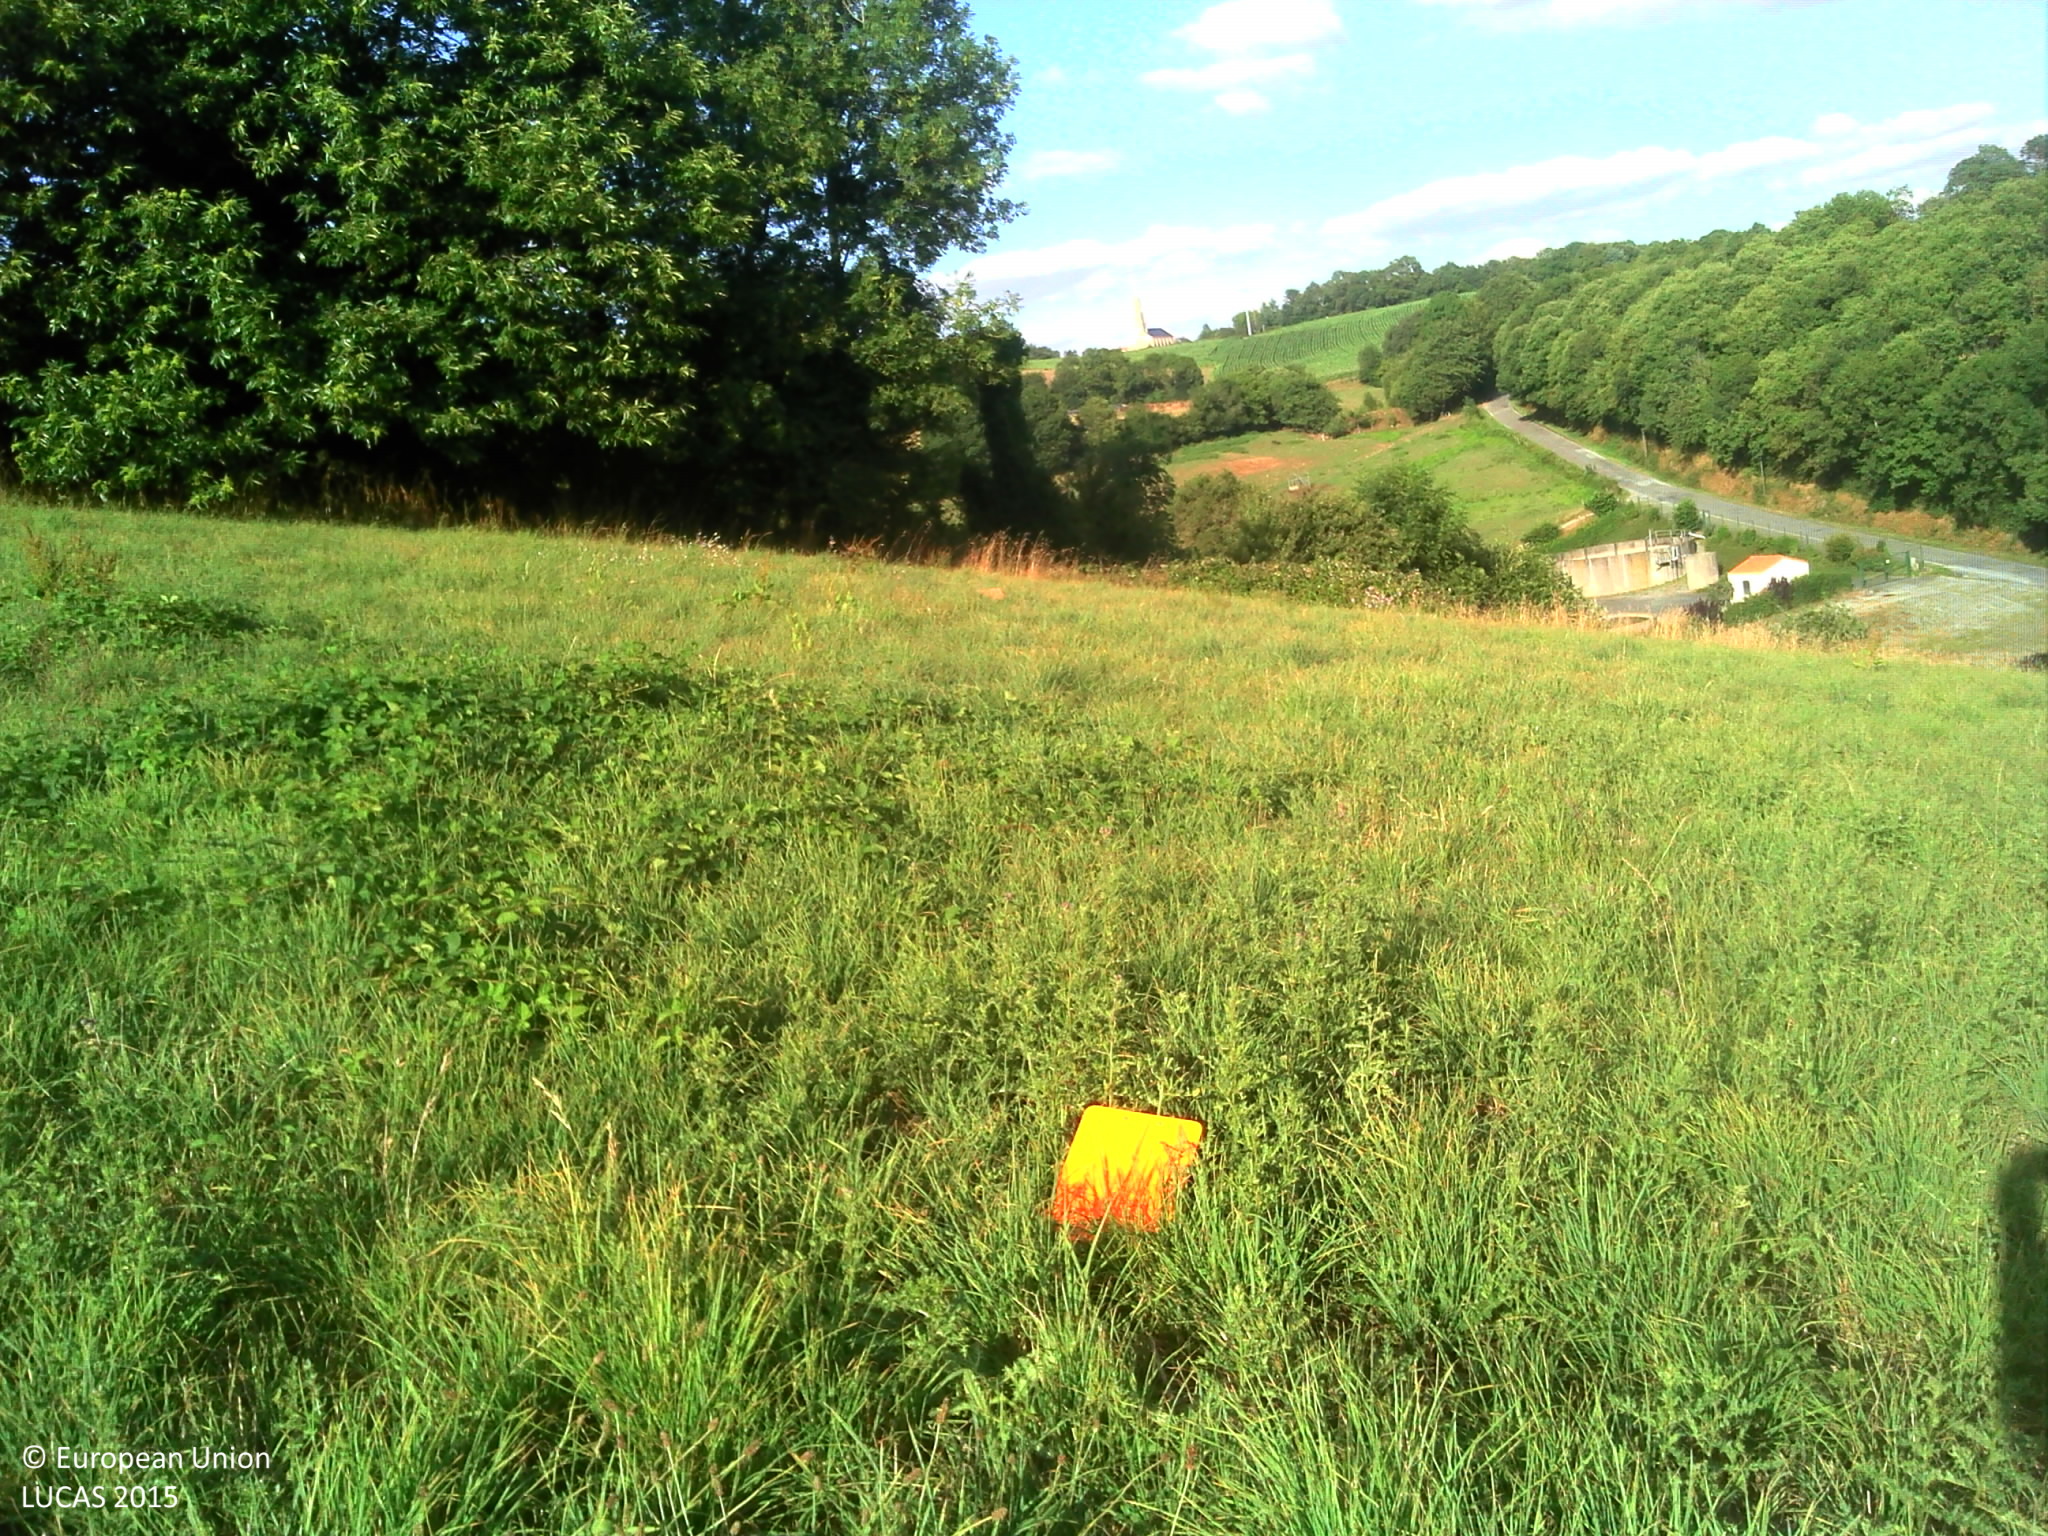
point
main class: Grassland
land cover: Grassland without tree/shrub cover
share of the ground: > 75 %
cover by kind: herbaceous plants 100 %
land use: Agriculture (excluding fallow land and kitchen gardens)
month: July
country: FR
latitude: 46.8279
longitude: -0.8999
